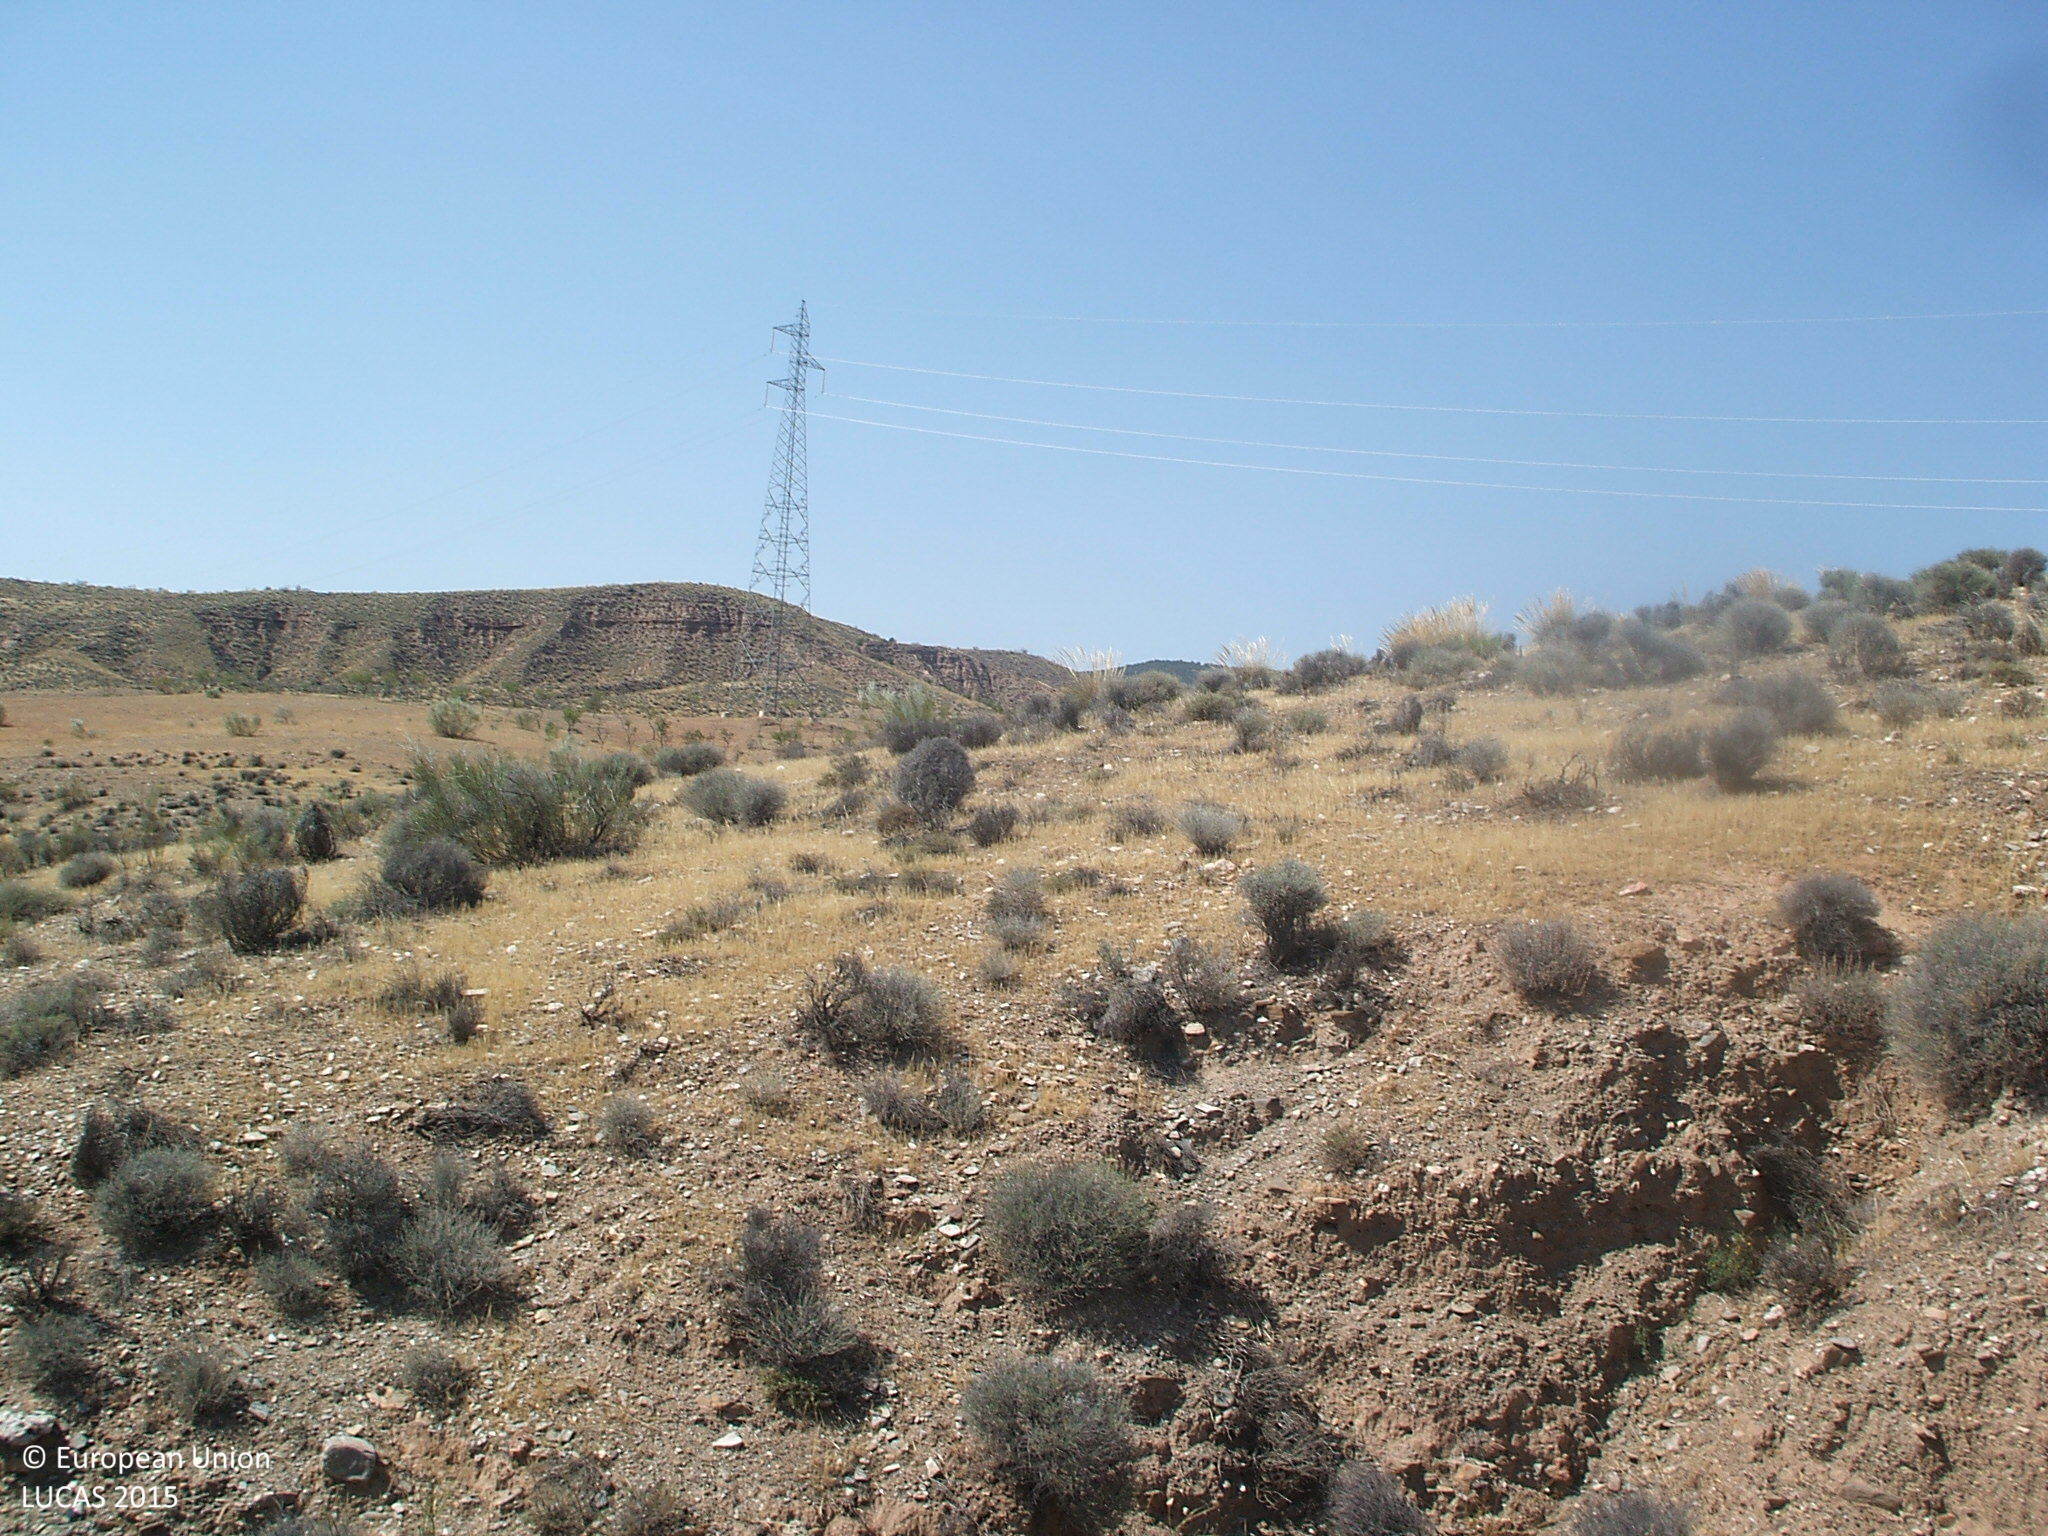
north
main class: Shrubland
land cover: Shrubland without tree cover
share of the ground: 50 - 75 %
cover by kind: shrubs 60 %, consolidated bare surface 40 %
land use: Semi-natural and natural areas not in use
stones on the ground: > 50 %
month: June
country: ES
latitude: 37.2004
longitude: -2.8611
